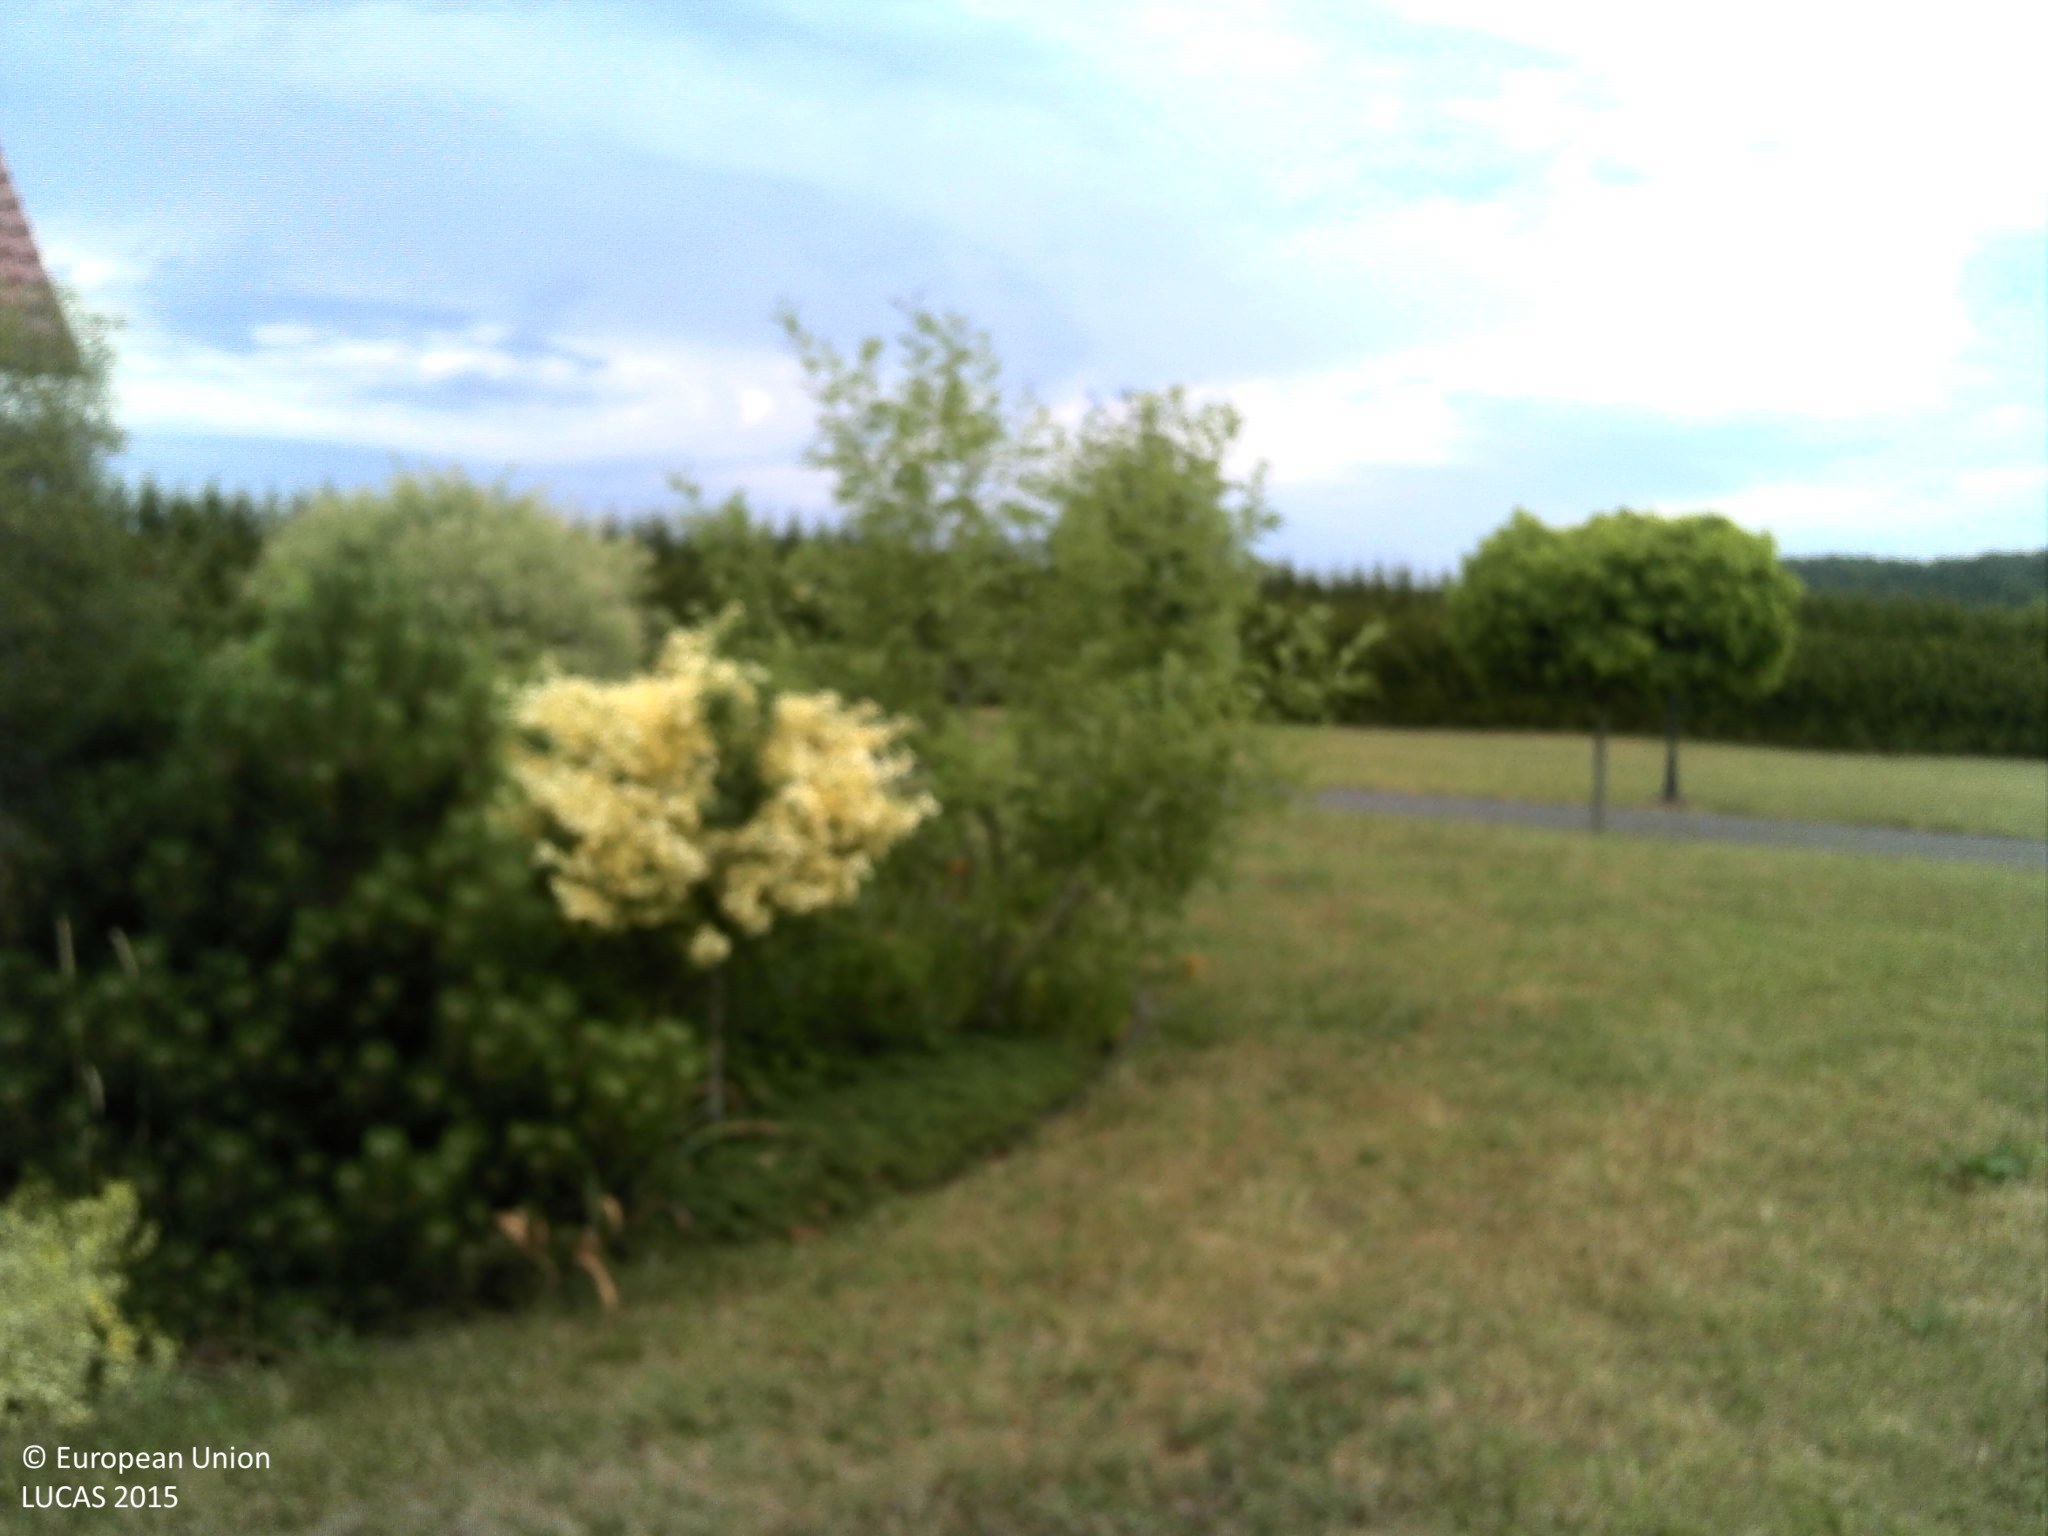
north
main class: Grassland
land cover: Grassland without tree/shrub cover
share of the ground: > 75 %
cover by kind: herbaceous plants 100 %
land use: Residential
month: July
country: FR
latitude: 49.4100
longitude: 6.4853
